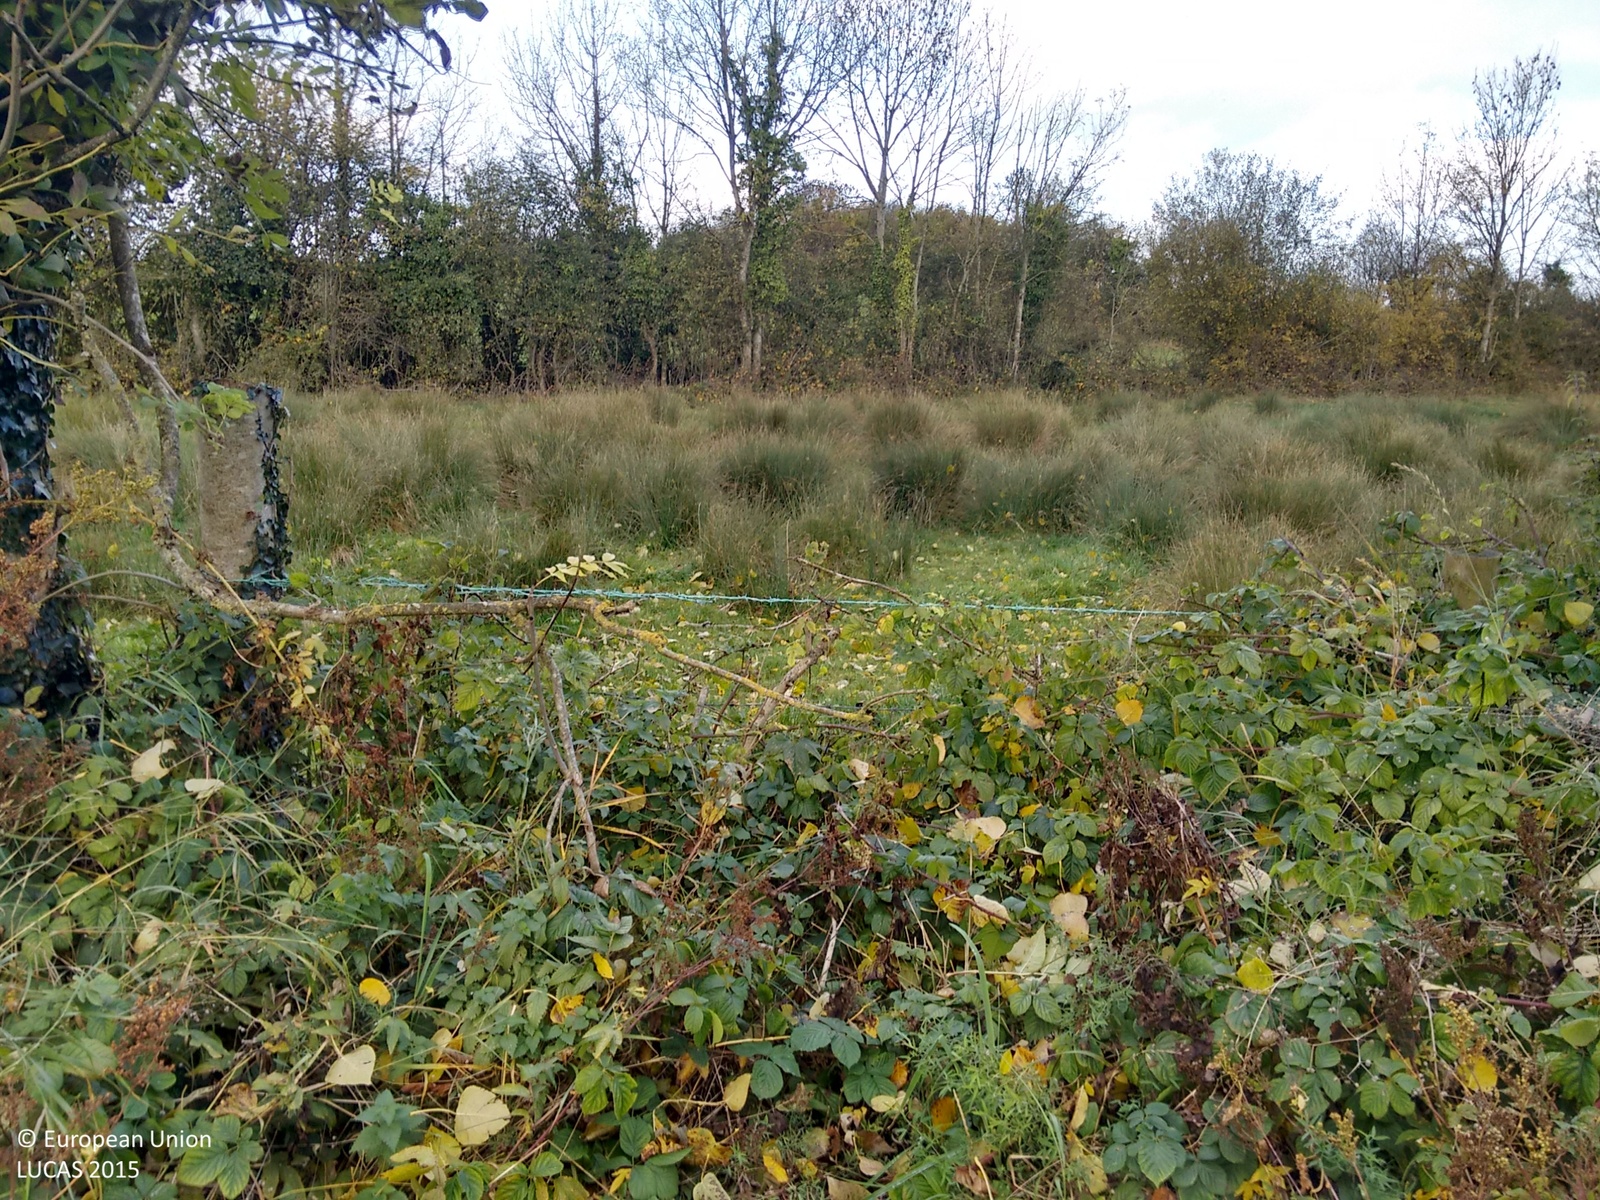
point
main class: Grassland
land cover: Grassland without tree/shrub cover
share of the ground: > 75 %
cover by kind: herbaceous plants 70 %, shrubs 5 %, consolidated bare surface 5 %
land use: Agriculture (excluding fallow land and kitchen gardens)
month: October
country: IE
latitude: 53.1814
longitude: -7.7488
